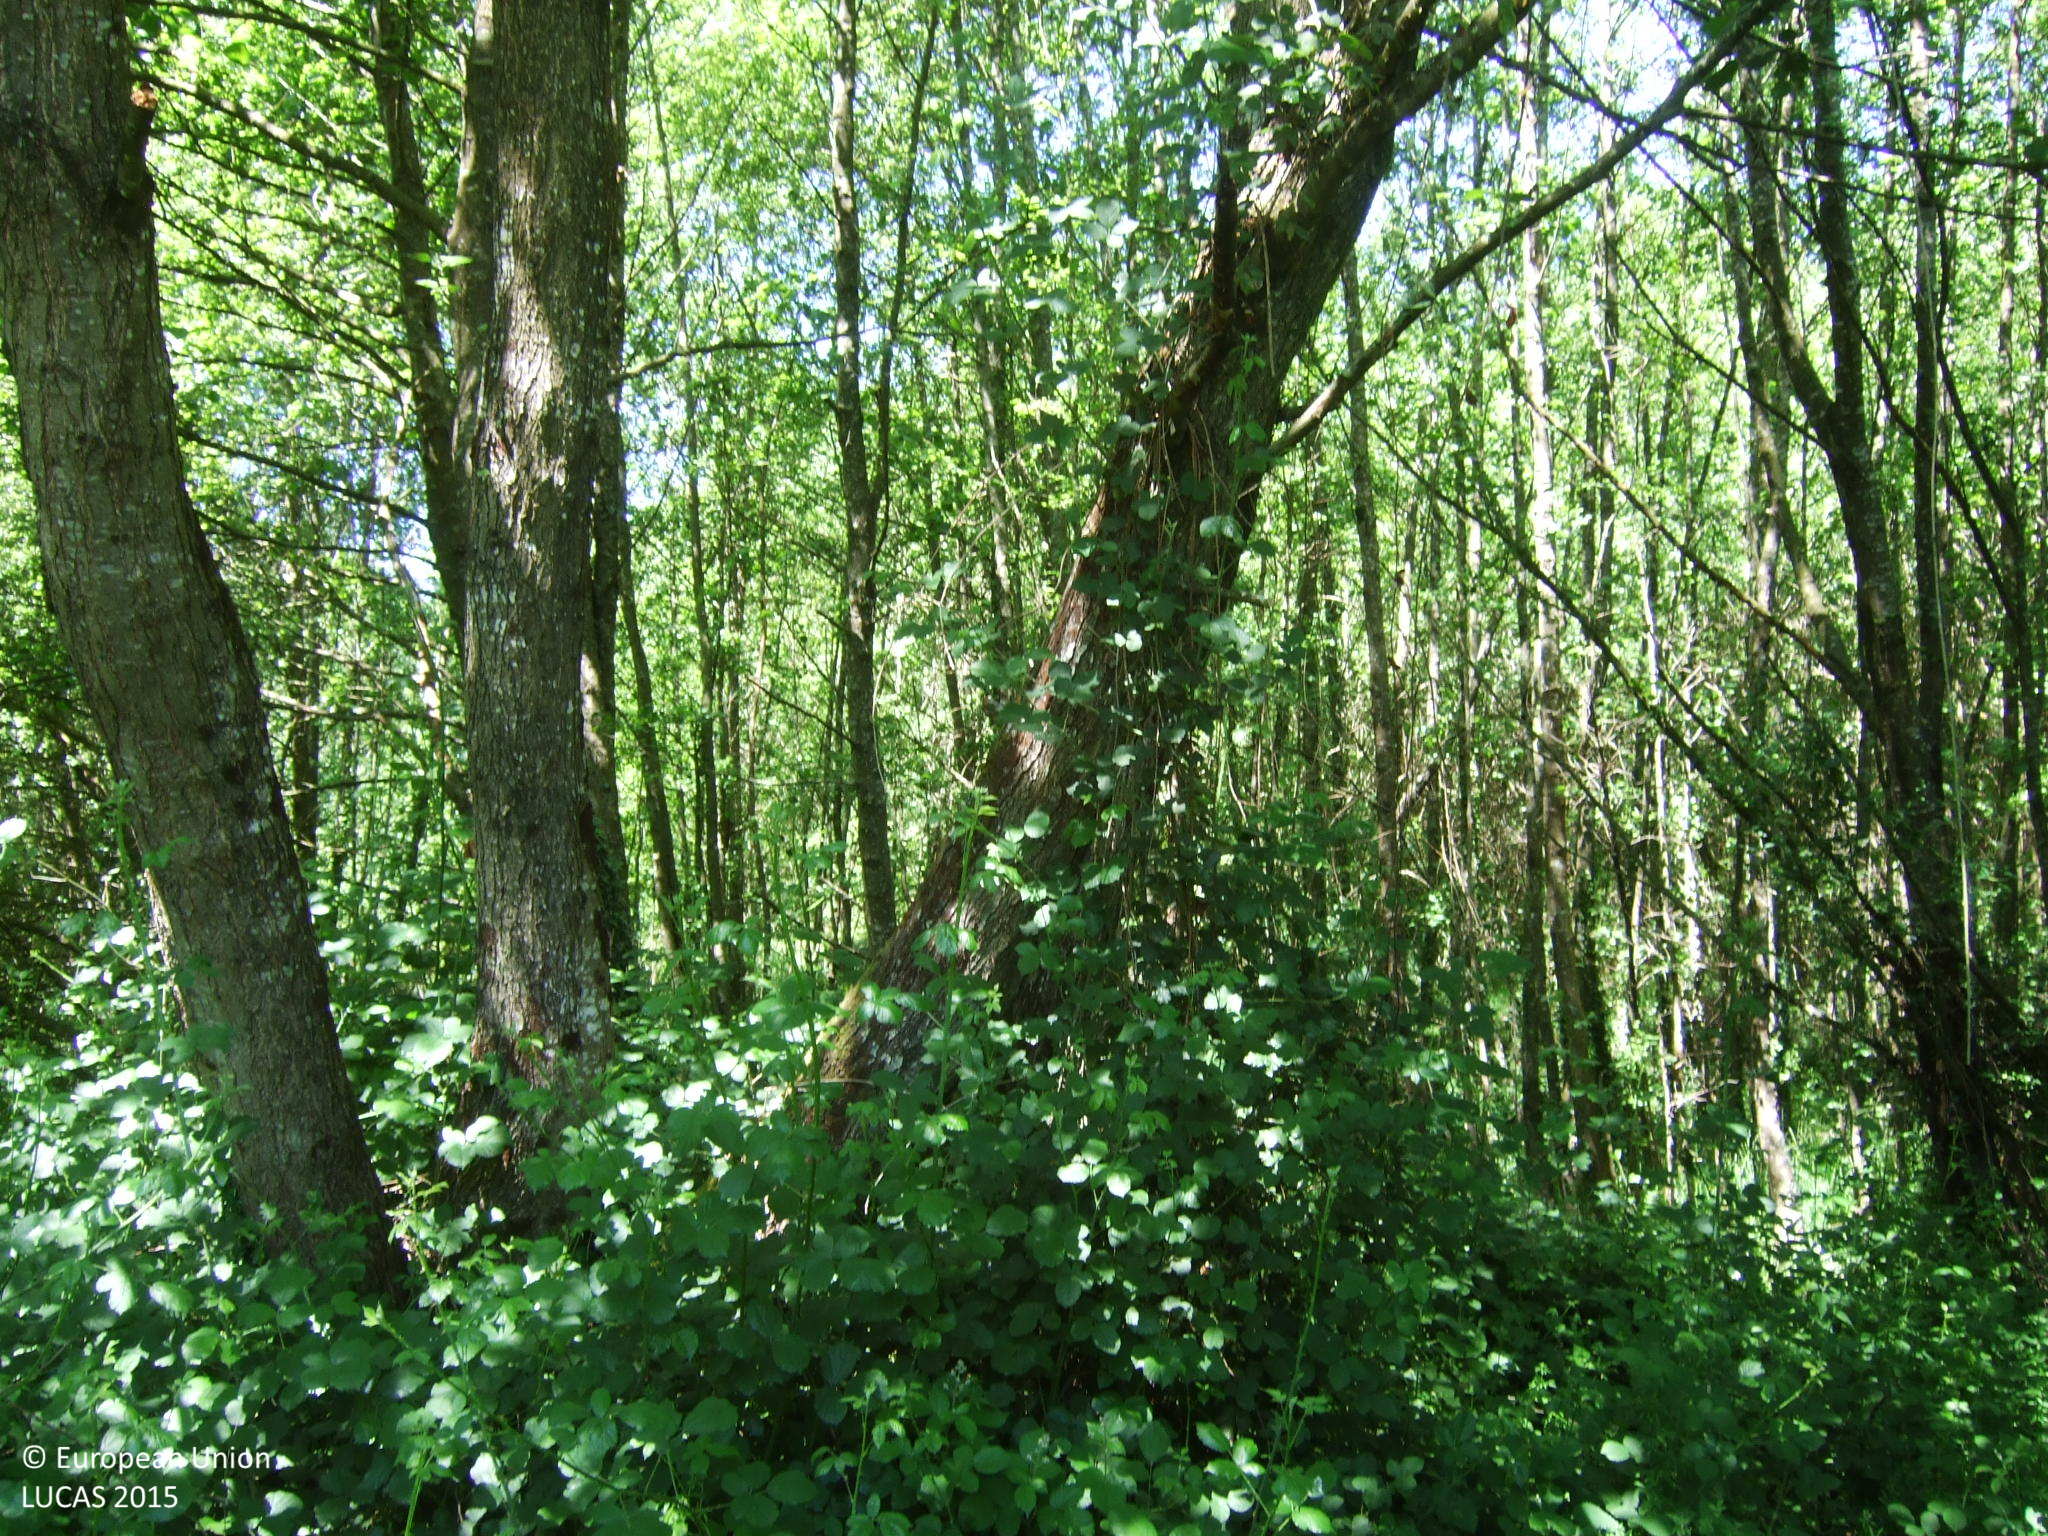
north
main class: Woodland
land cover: Broadleaved woodland
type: acidophilous oak and oak-birch forest
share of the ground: > 75 %
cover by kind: broadleaved forest trees 80 %, shrubs 20 %
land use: Semi-natural and natural areas not in use
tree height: > 5 m
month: May
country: ES
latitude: 42.8697
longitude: -7.5932
